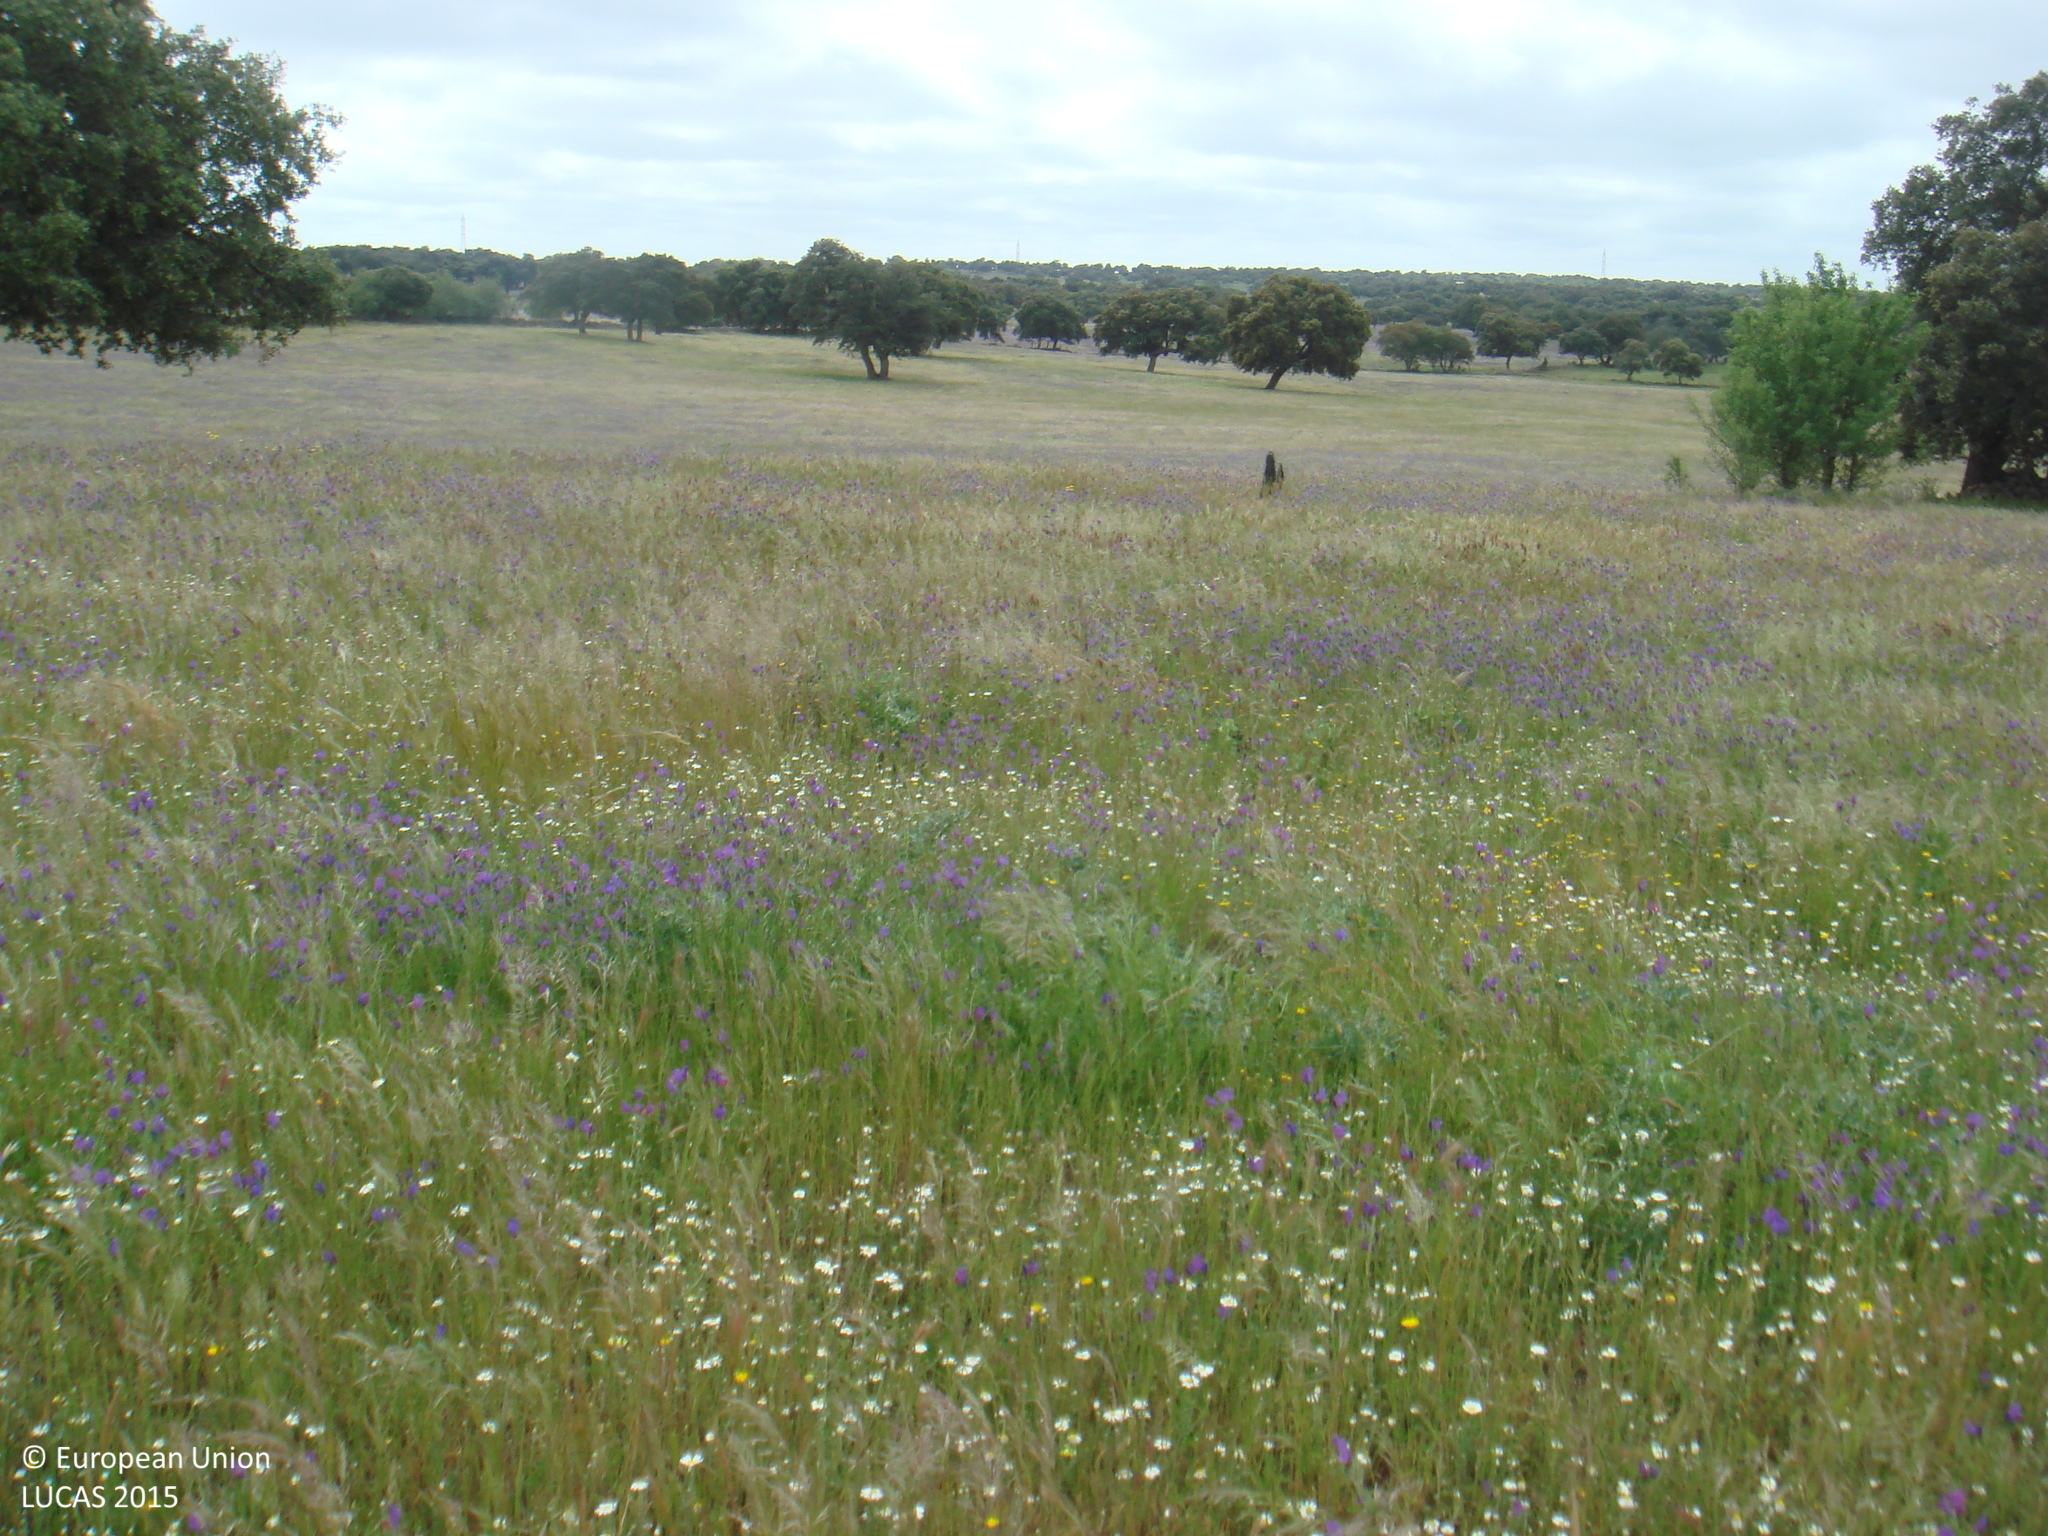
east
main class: Grassland
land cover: Grassland without tree/shrub cover
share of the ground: > 75 %
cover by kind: herbaceous plants 100 %
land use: Agriculture (excluding fallow land and kitchen gardens)
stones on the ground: < 10 %
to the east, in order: Grassland without tree/shrub cover; Broadleaved woodland; Grassland without tree/shrub cover; Dry stone walls; Fences; Broadleaved woodland; Grassland with sparse tree/shrub cover
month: May
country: ES
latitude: 38.4091
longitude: -4.7614
